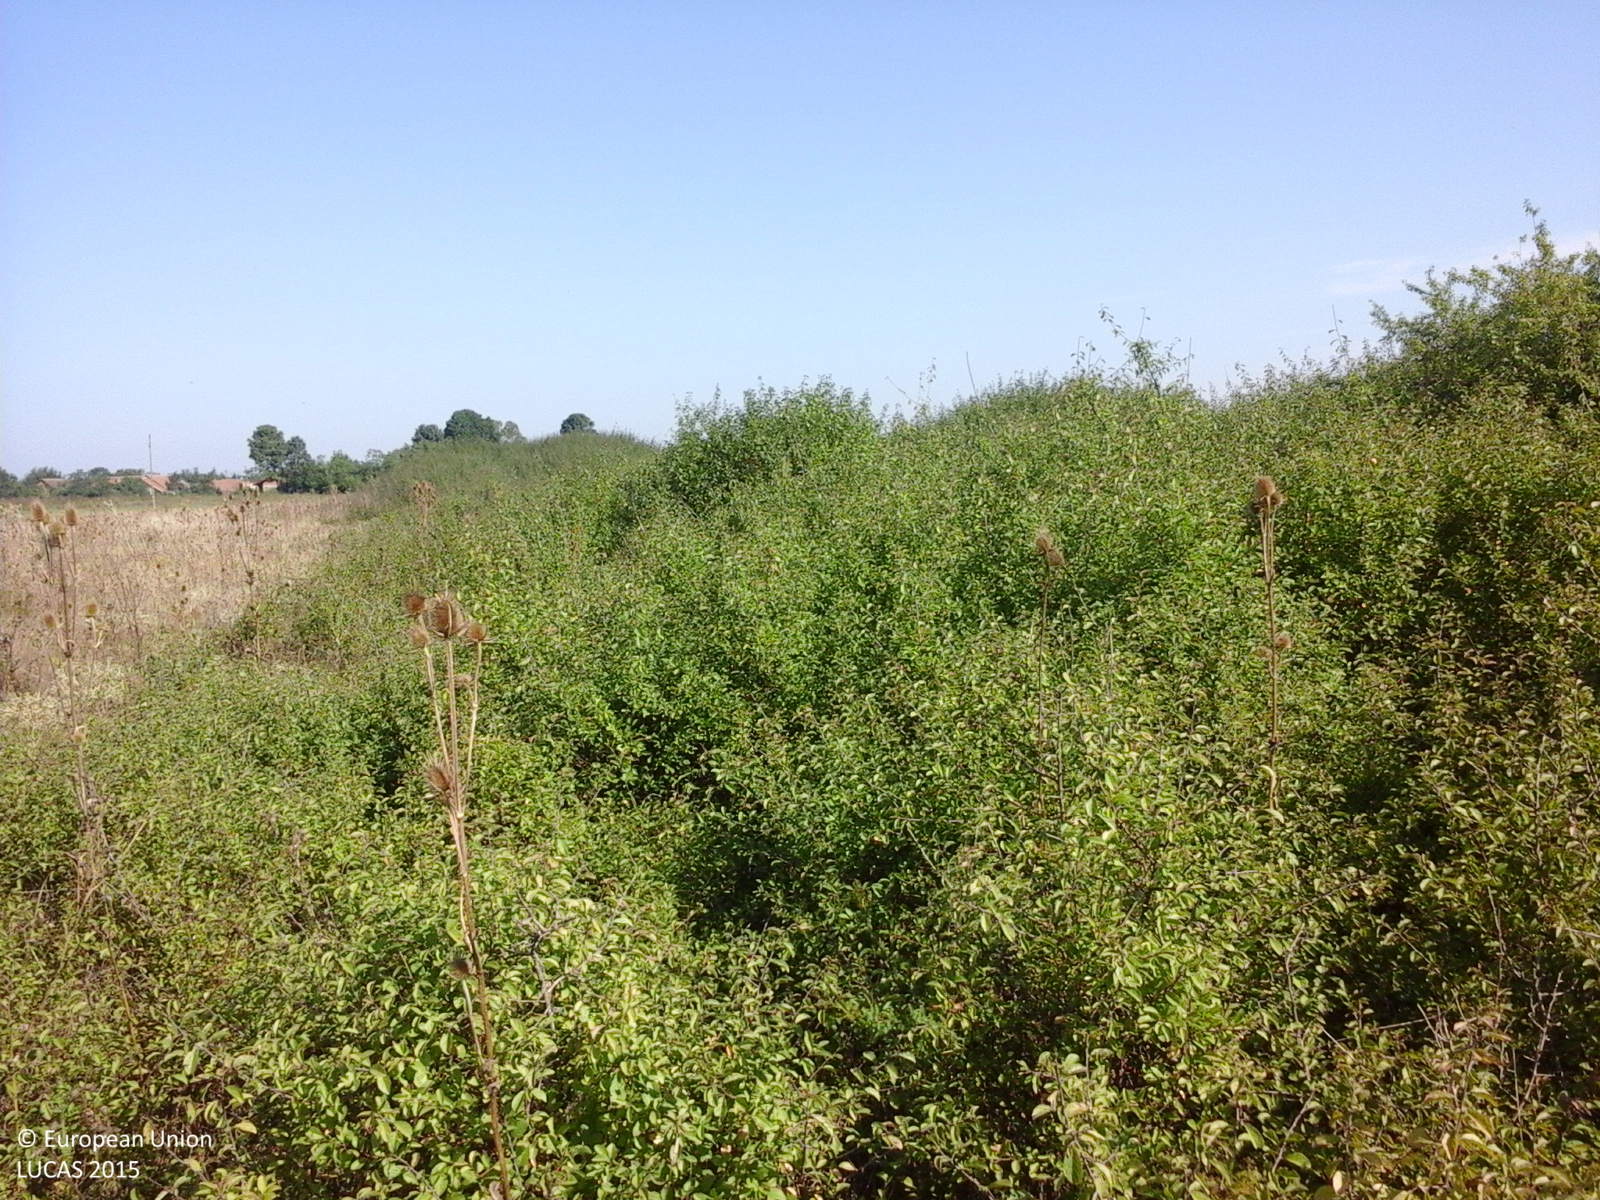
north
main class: Shrubland
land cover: Shrubland without tree cover
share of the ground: > 75 %
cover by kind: shrubs 95 %, herbaceous plants 5 %
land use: Semi-natural and natural areas not in use
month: August
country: RO
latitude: 45.6705
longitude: 21.3663
